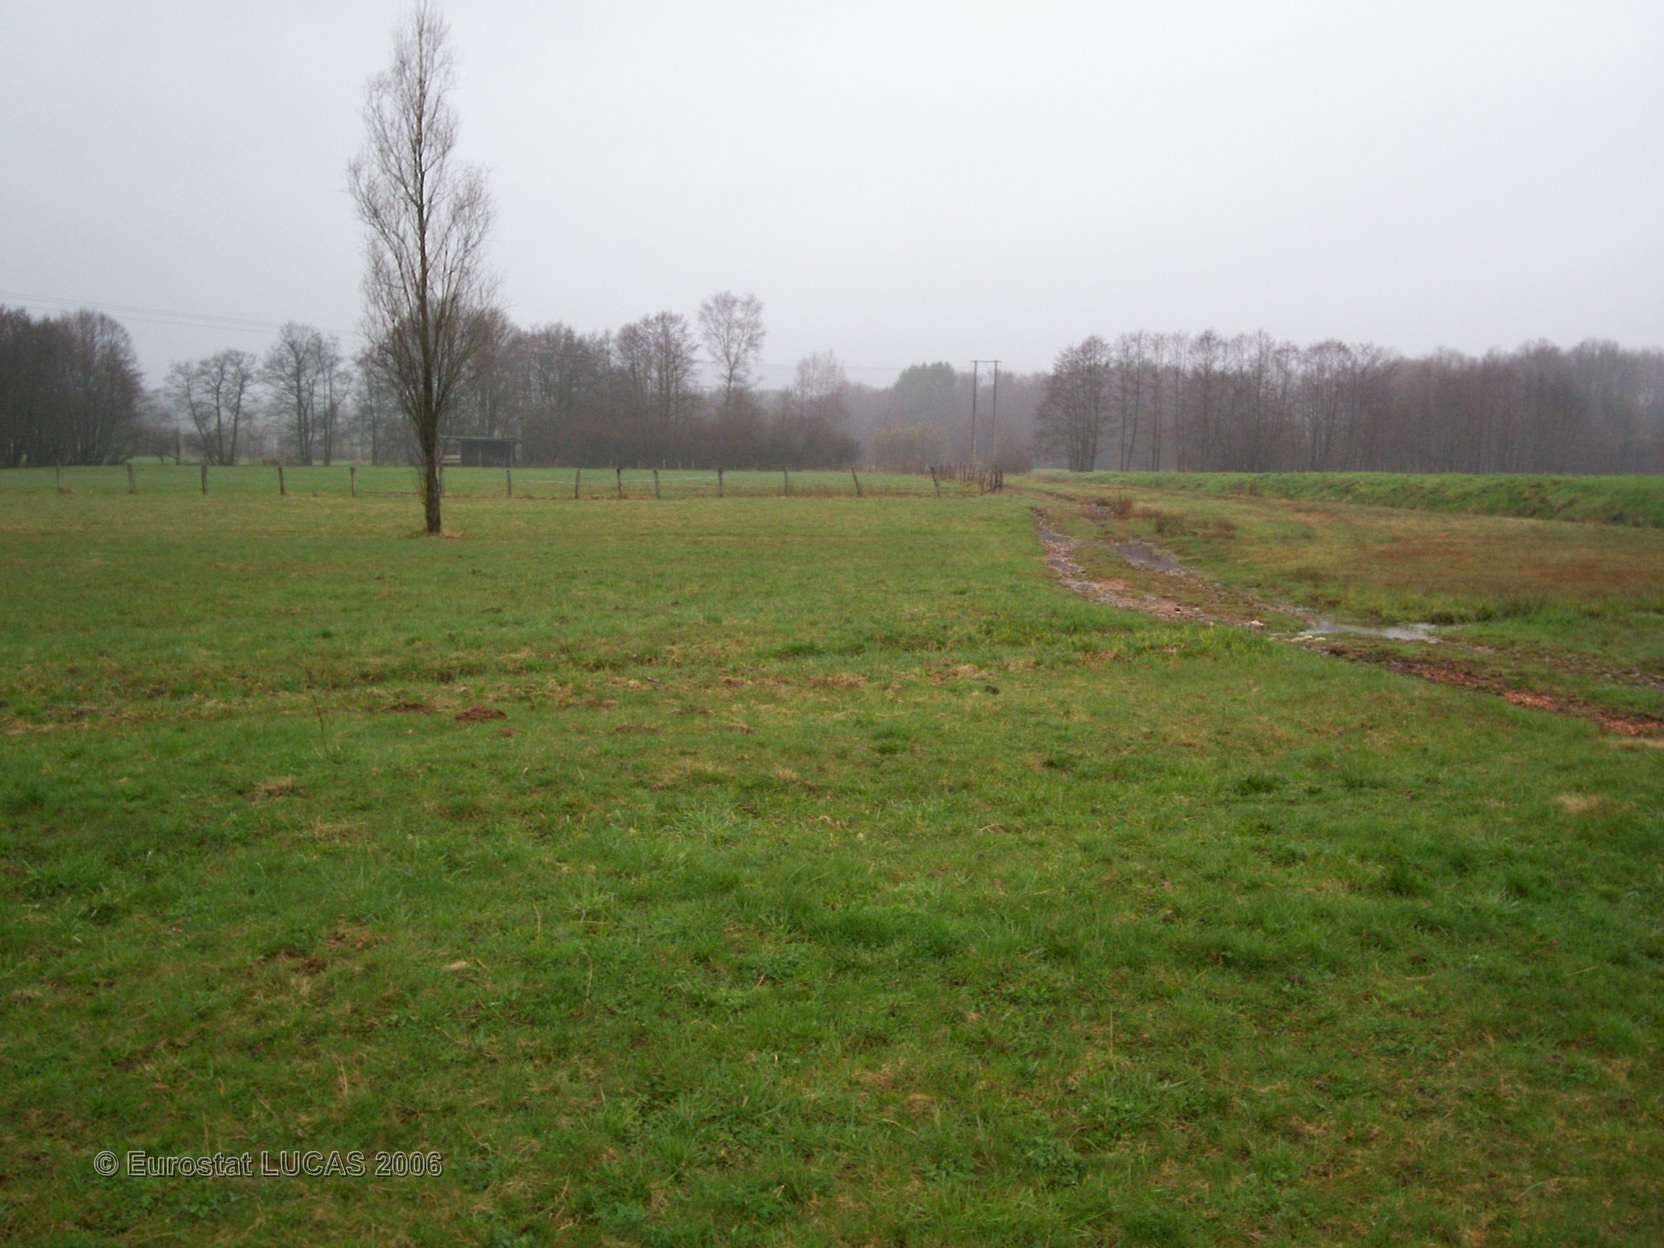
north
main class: Grassland
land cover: Grassland without tree/shrub cover
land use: Agriculture (excluding fallow land and kitchen gardens)
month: April
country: FR
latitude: 47.7093
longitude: 6.8160
